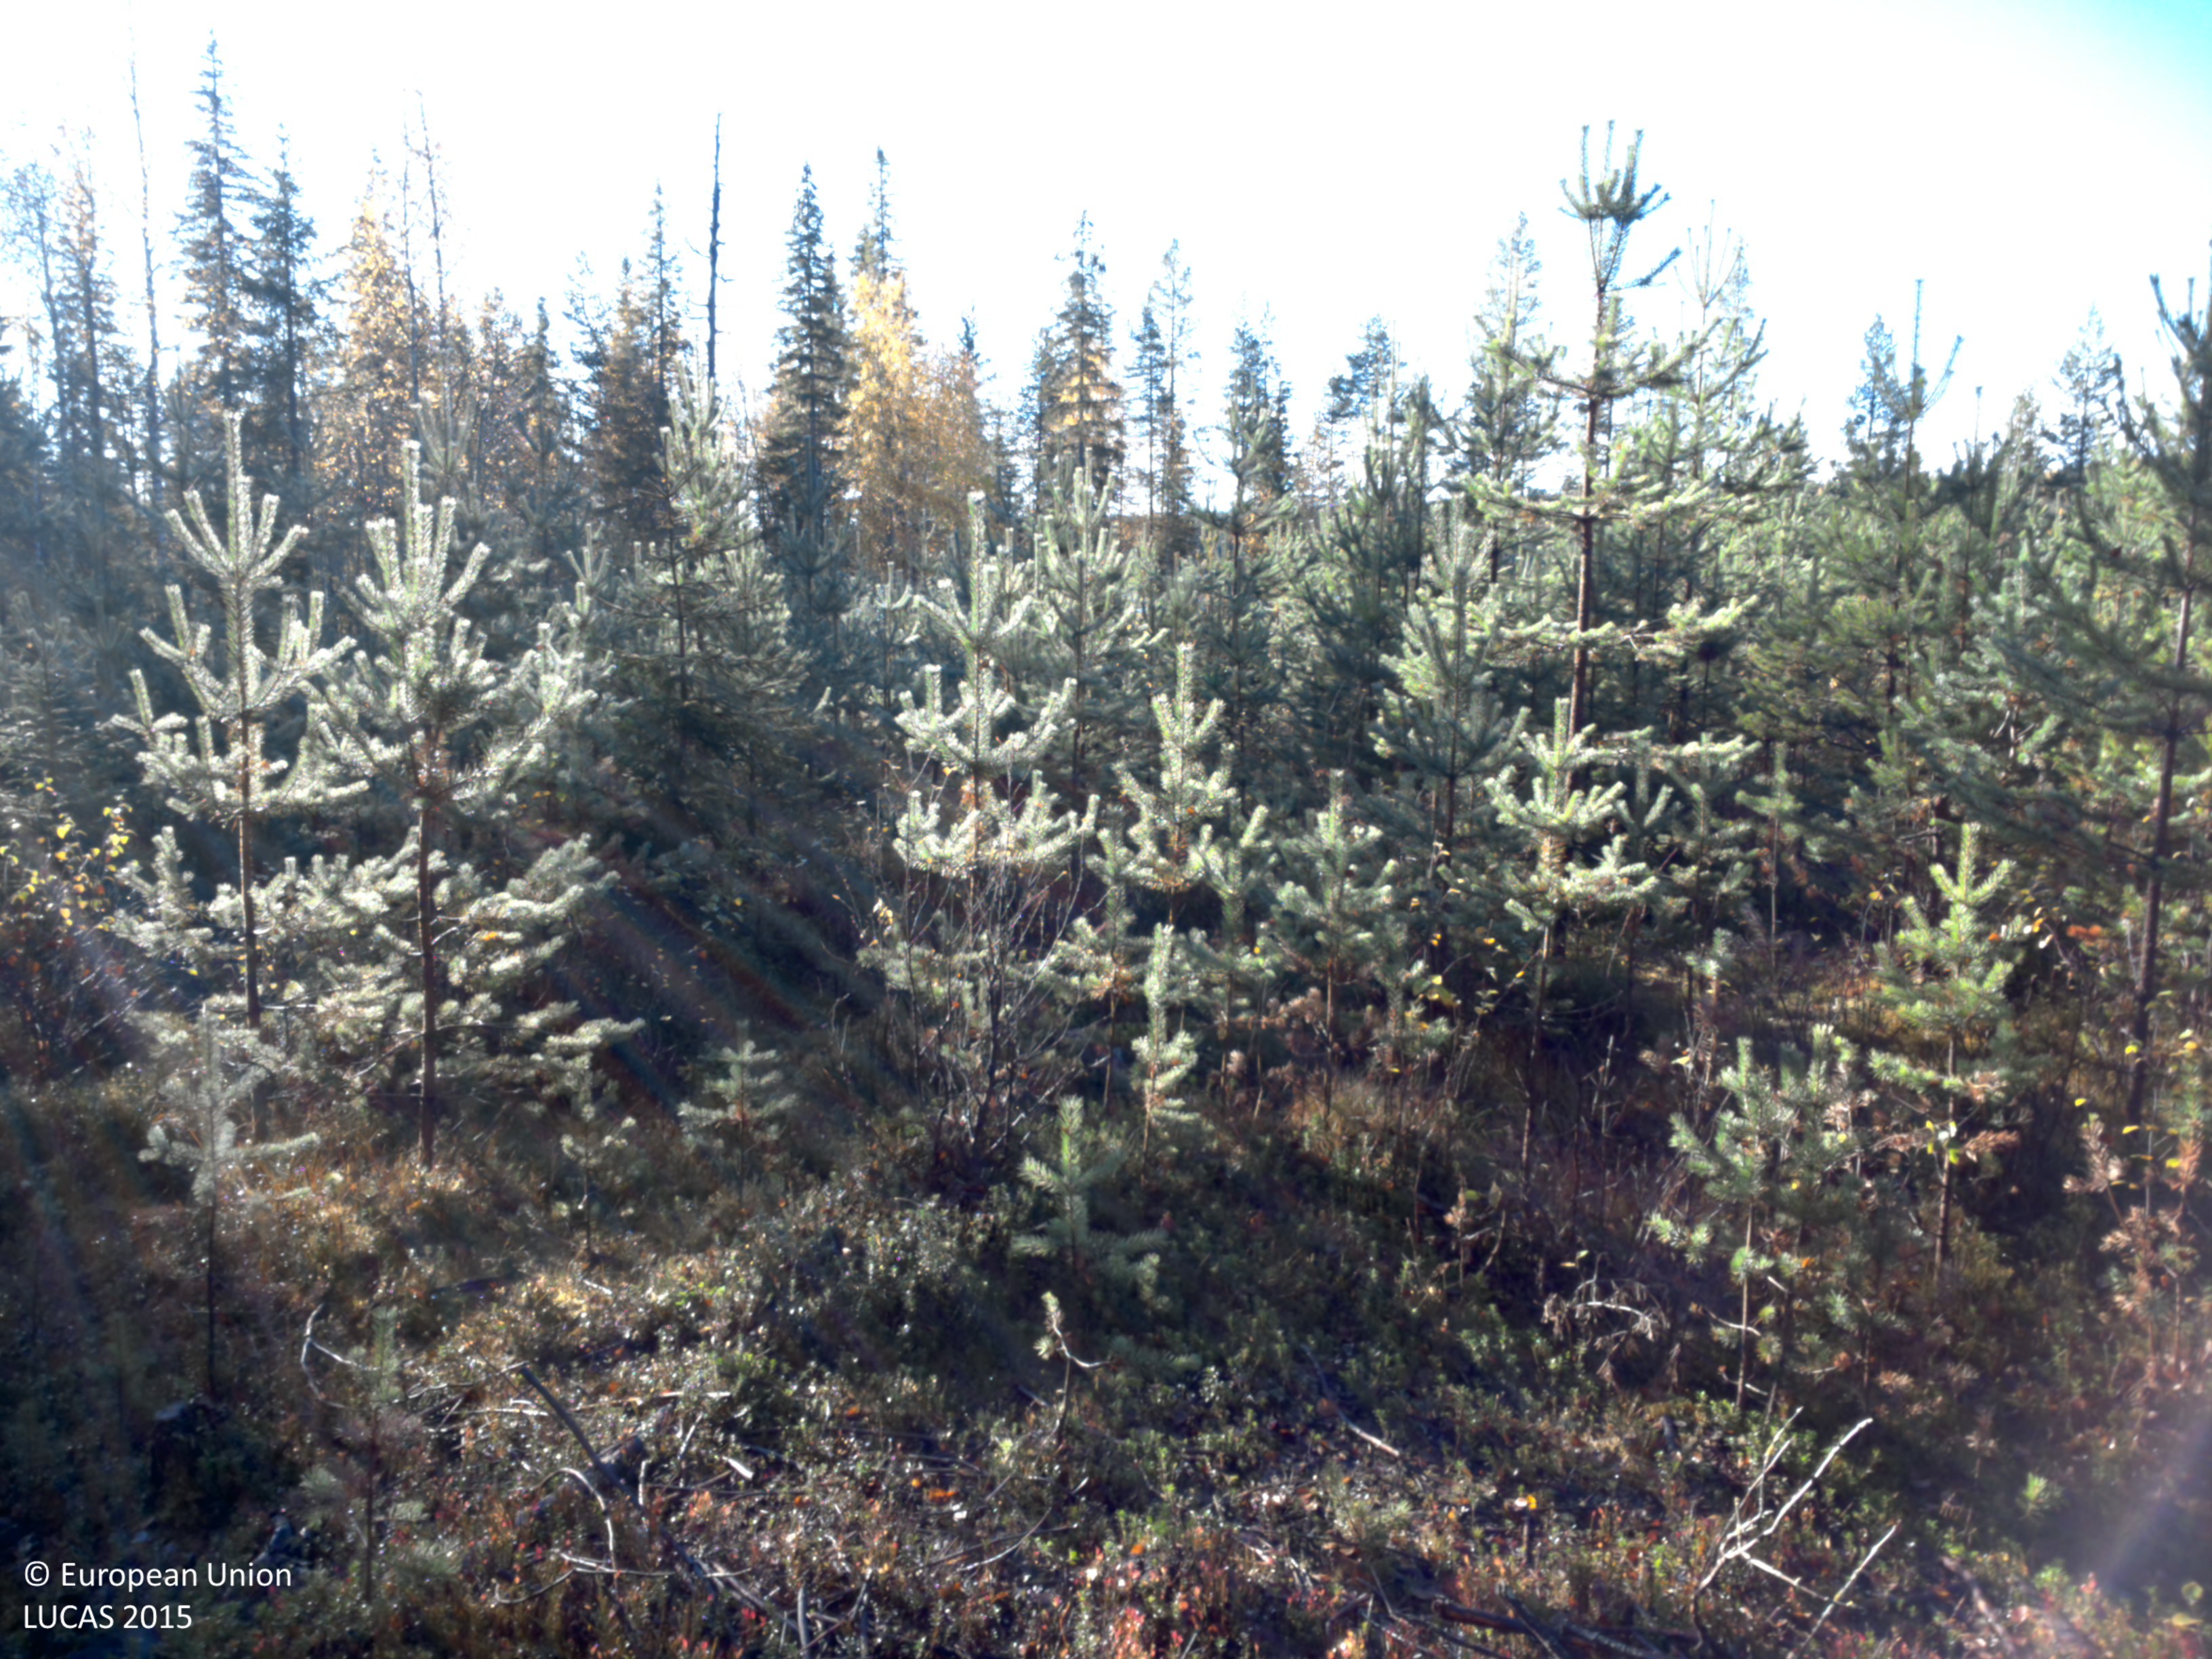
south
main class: Woodland
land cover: Pine dominated mixed woodland
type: boreal forest
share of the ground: > 75 %
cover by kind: coniferous forest trees 60 %, broadleaved forest trees 20 %, shrubs 15 %, lichens and mosses 5 %
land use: Forestry
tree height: > 5 m
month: September
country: SE
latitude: 64.8156
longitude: 19.0024
